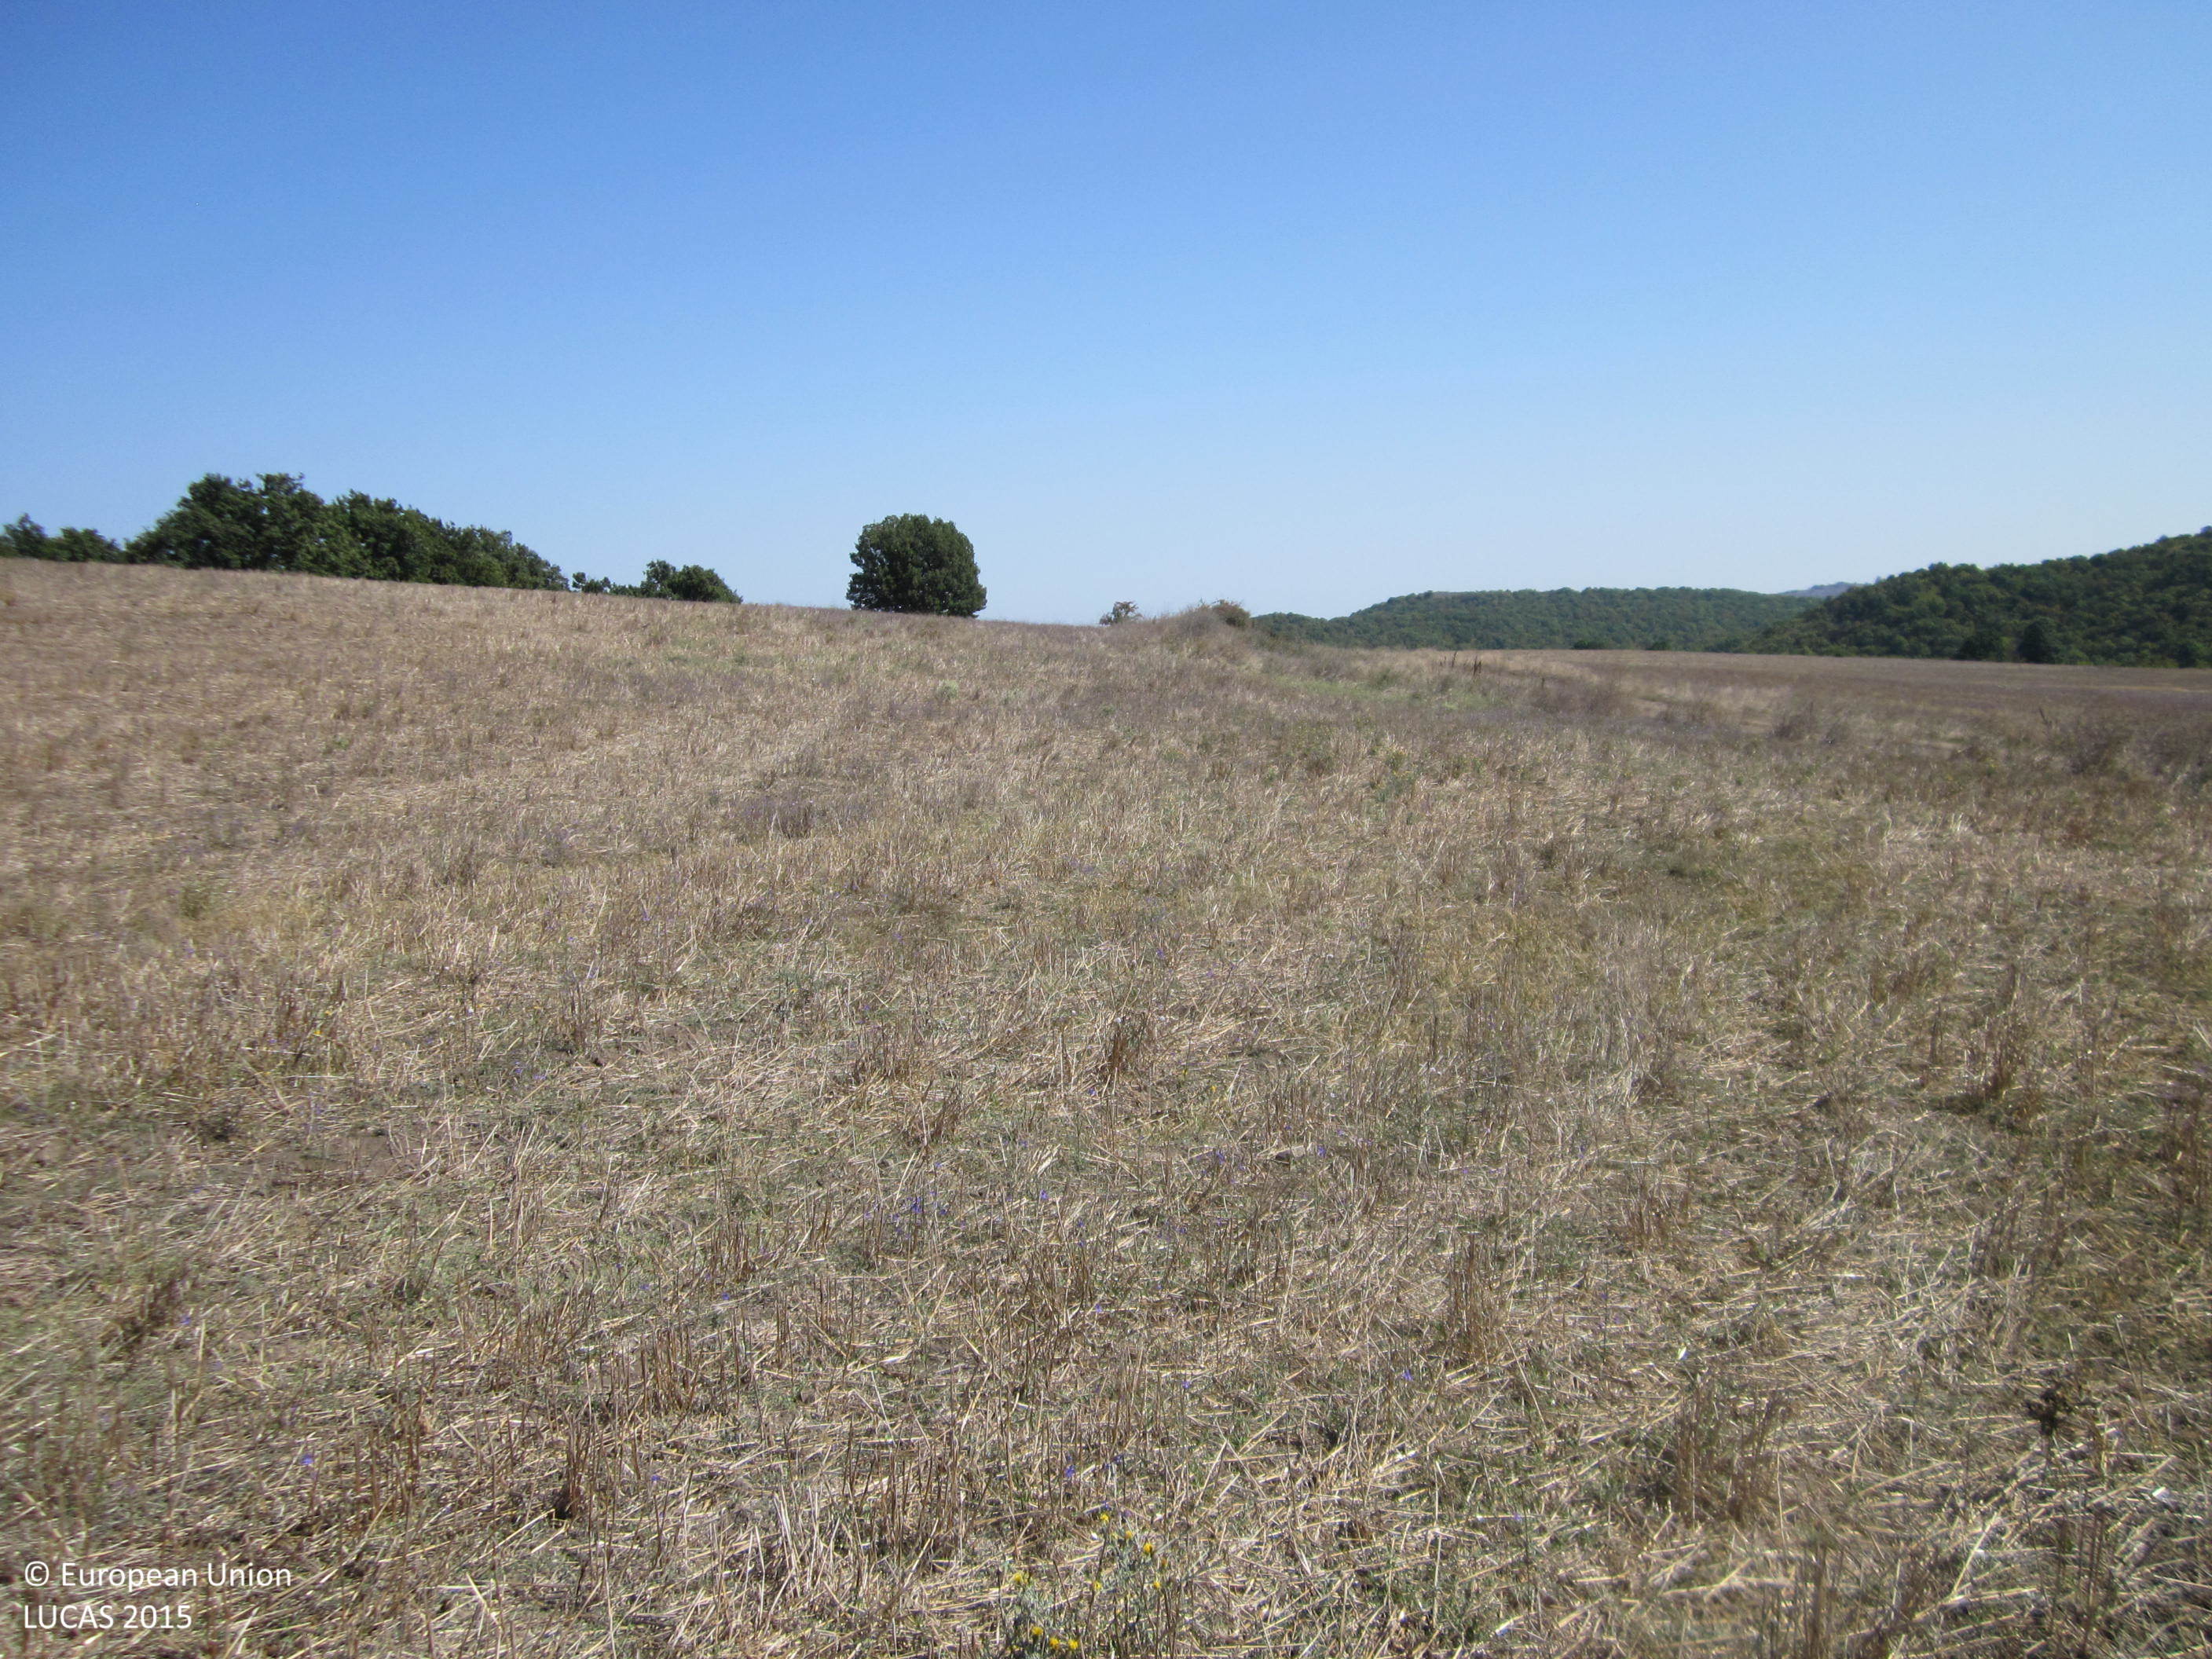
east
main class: Cropland
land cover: Common wheat
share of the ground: 50 - 75 %
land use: Agriculture (excluding fallow land and kitchen gardens)
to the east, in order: Common wheat; Grass margins; Tracks; Single bushes/trees; Tracks; Grass margins; Common wheat
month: September
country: BG
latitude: 42.7072
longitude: 27.4687
